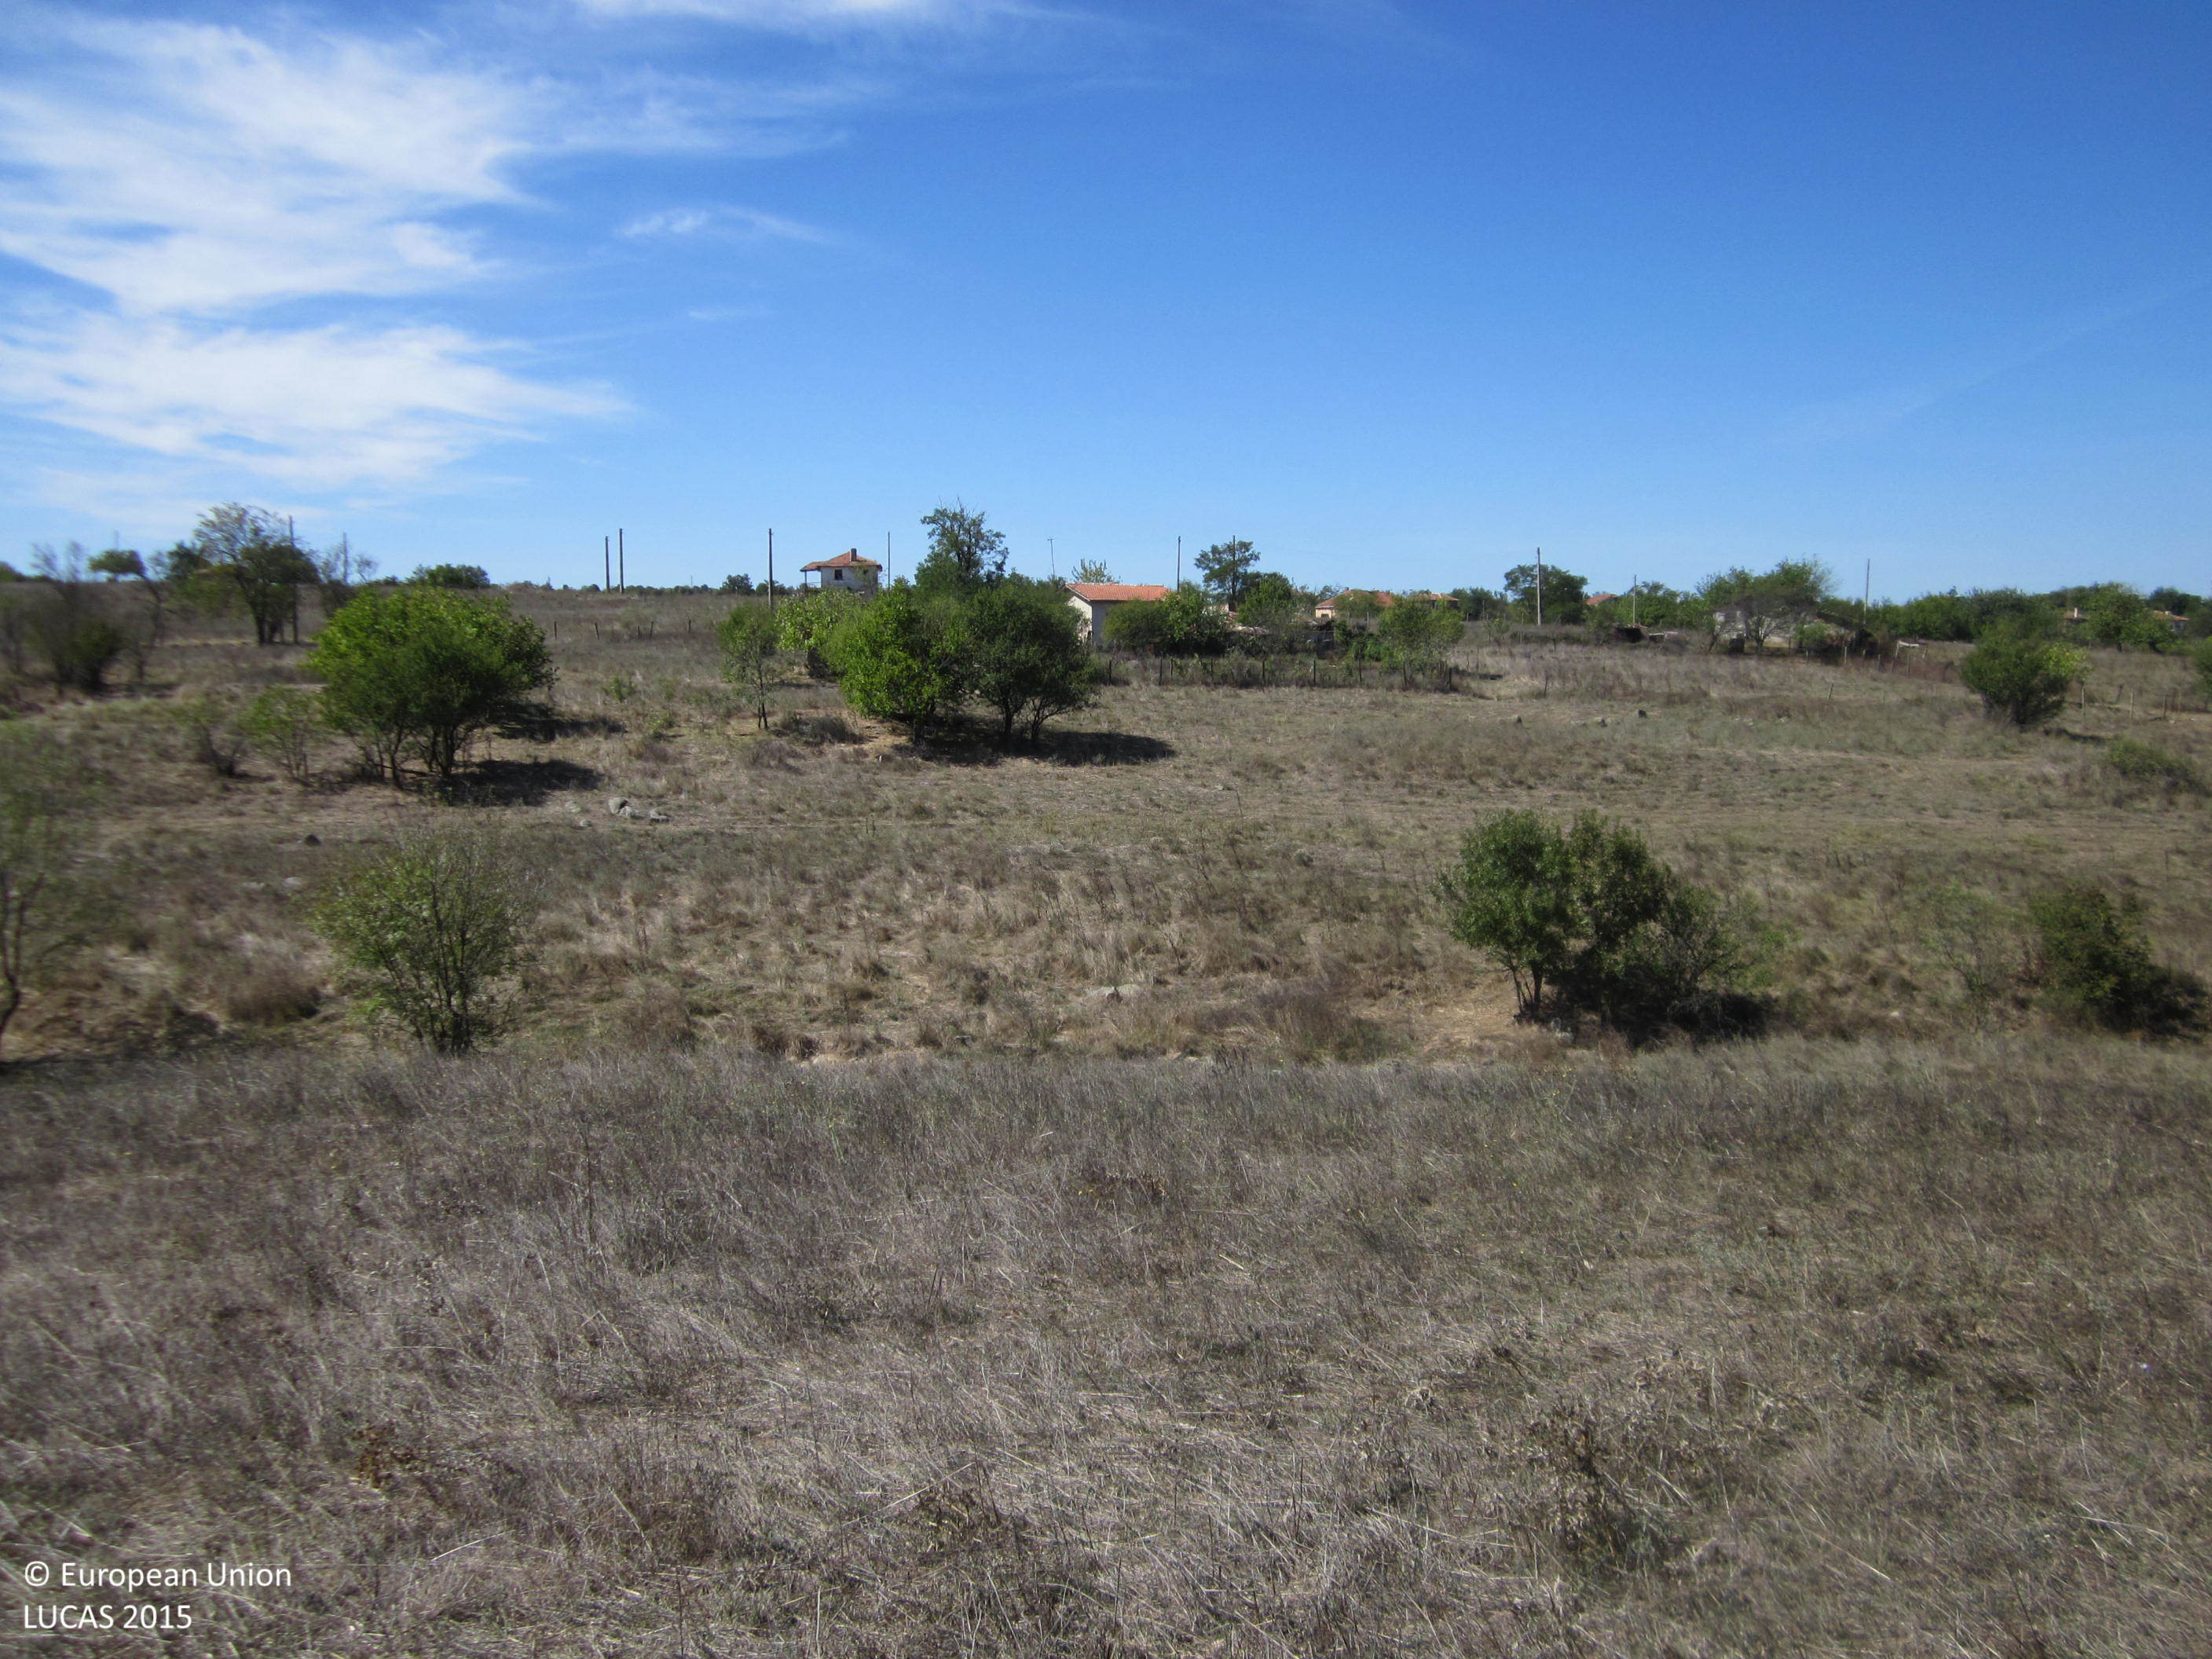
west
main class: Grassland
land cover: Grassland without tree/shrub cover
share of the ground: > 75 %
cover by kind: herbaceous plants 100 %
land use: Agriculture (excluding fallow land and kitchen gardens)
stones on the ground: < 10 %
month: September
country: BG
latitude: 42.2565
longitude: 26.9864
